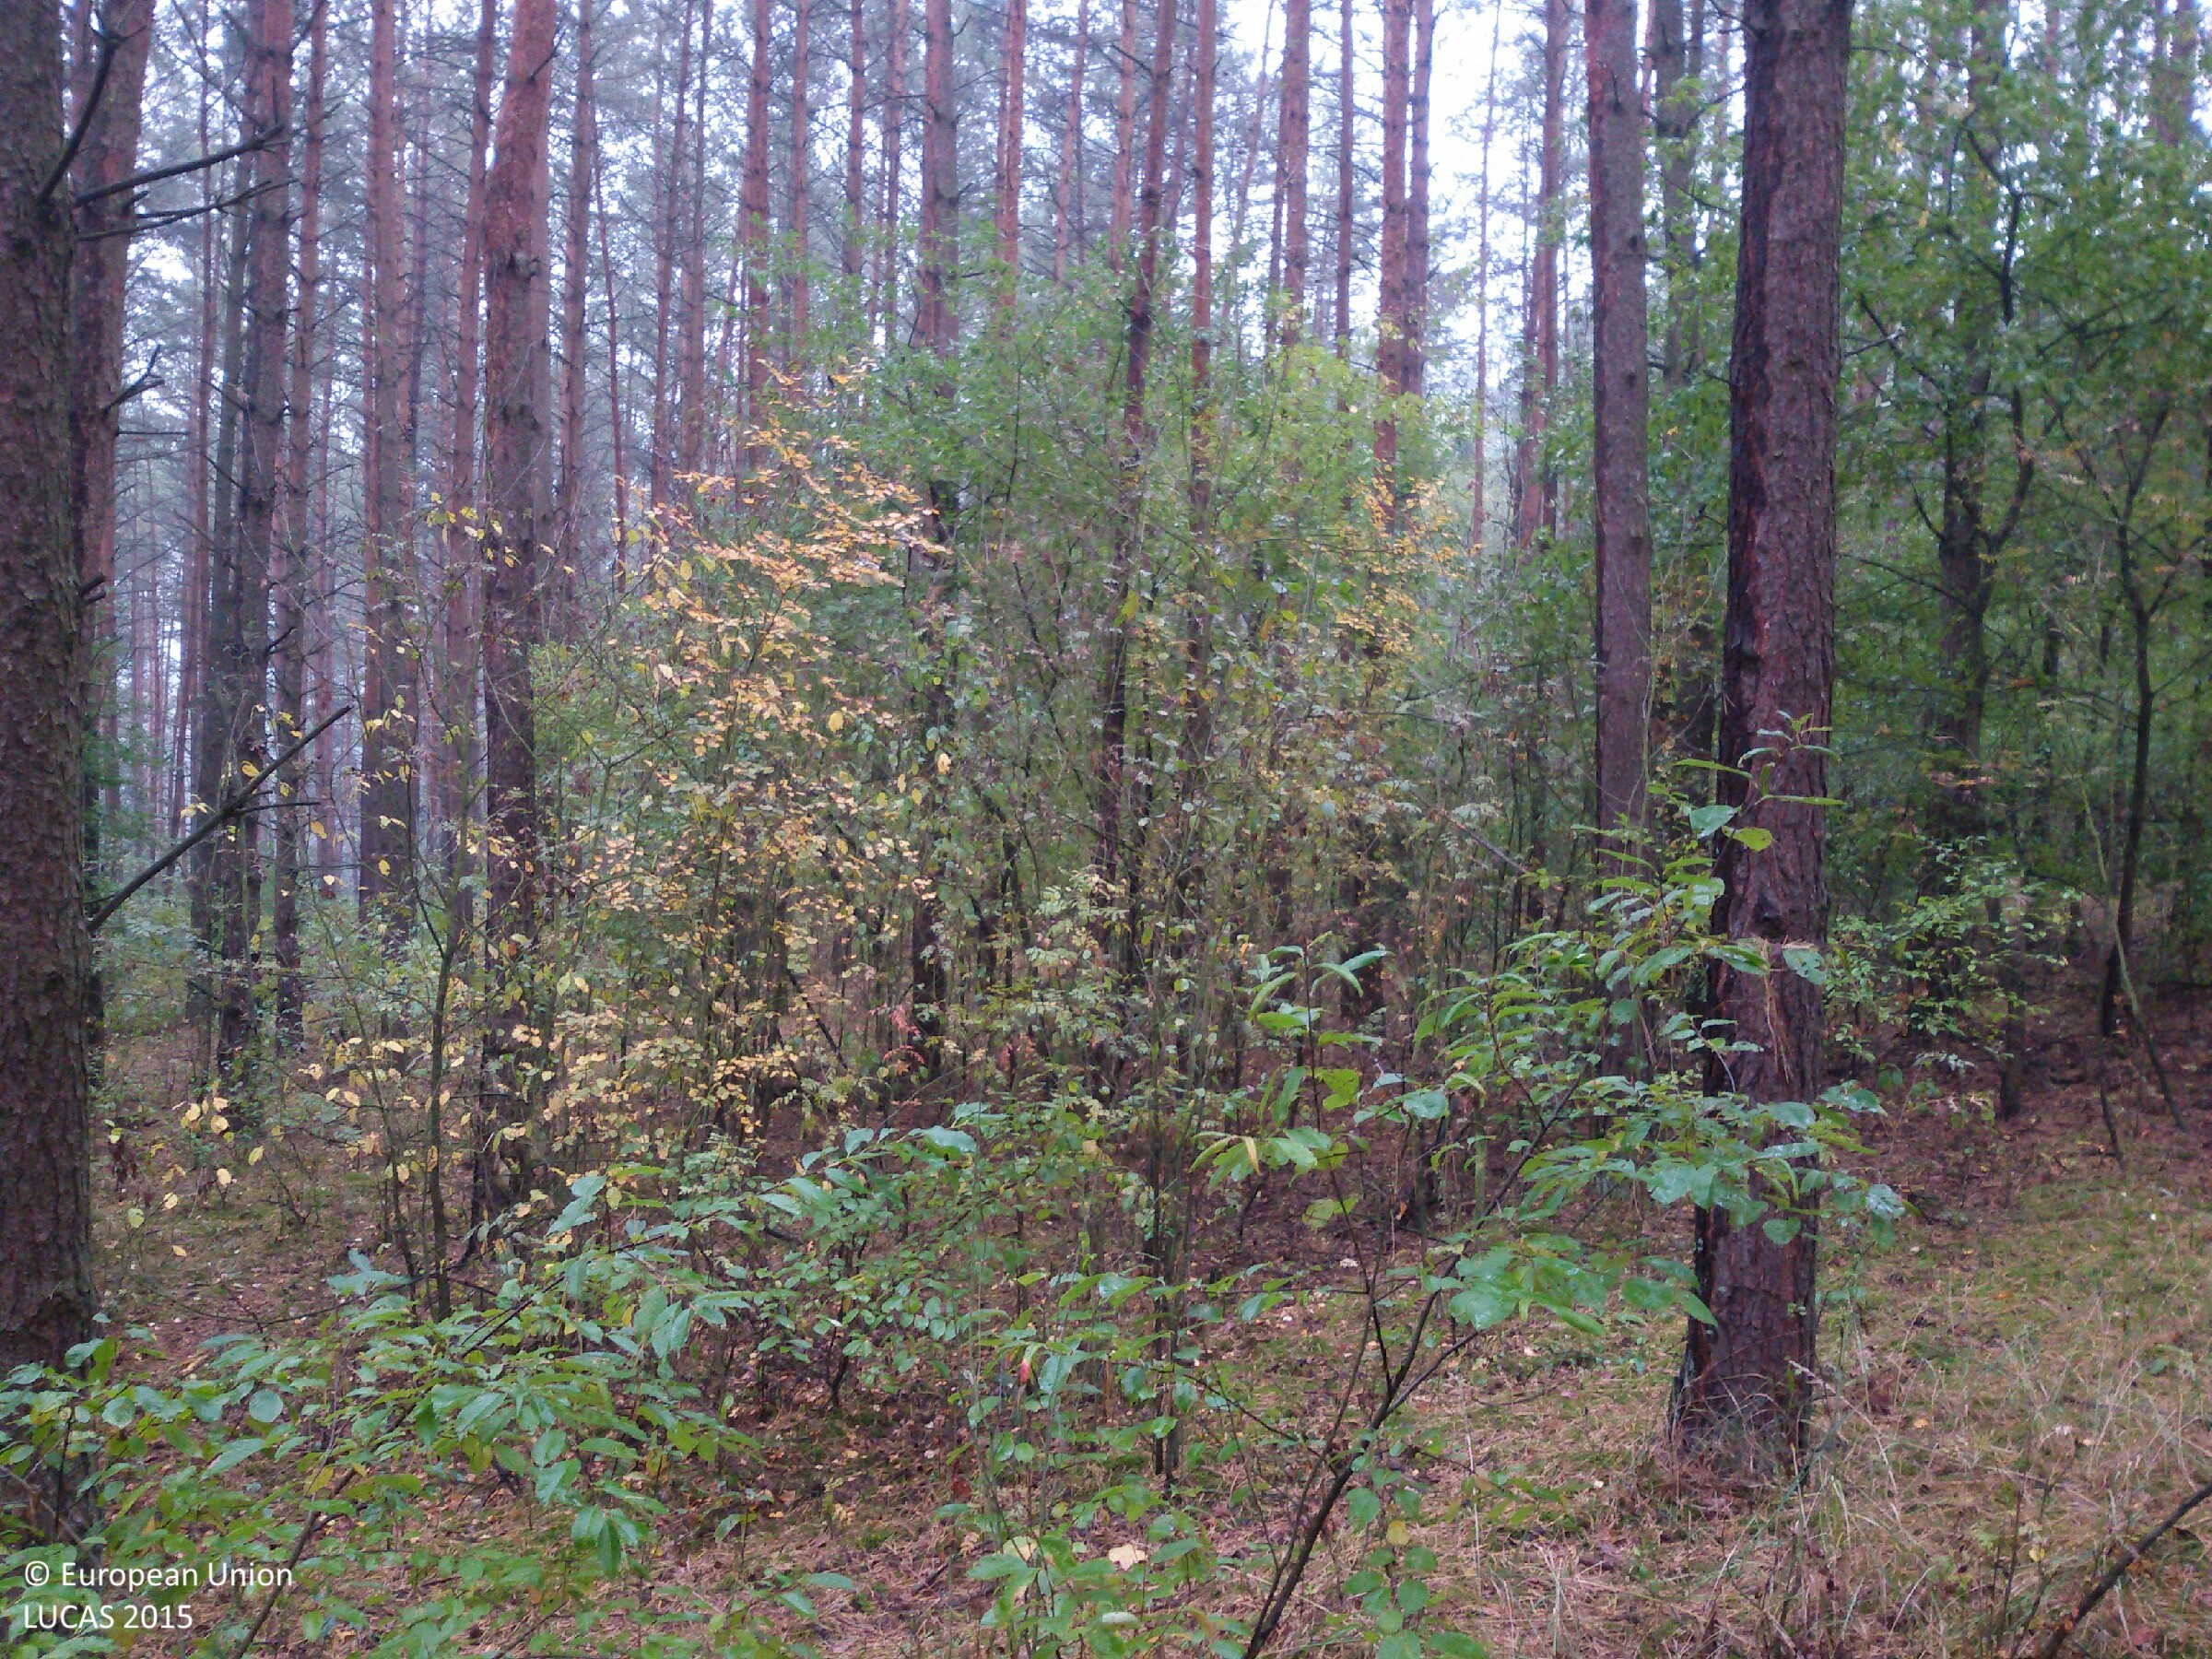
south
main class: Woodland
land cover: Pine dominated coniferous woodland
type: hemiboreal forest and nemoral coniferous forest and mixed broadleaved-coniferous forest
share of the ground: > 75 %
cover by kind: coniferous forest trees 70 %, lichens and mosses 20 %, broadleaved forest trees 10 %
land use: Forestry
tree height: > 5 m
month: October
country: PL
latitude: 53.4652
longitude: 19.2278
